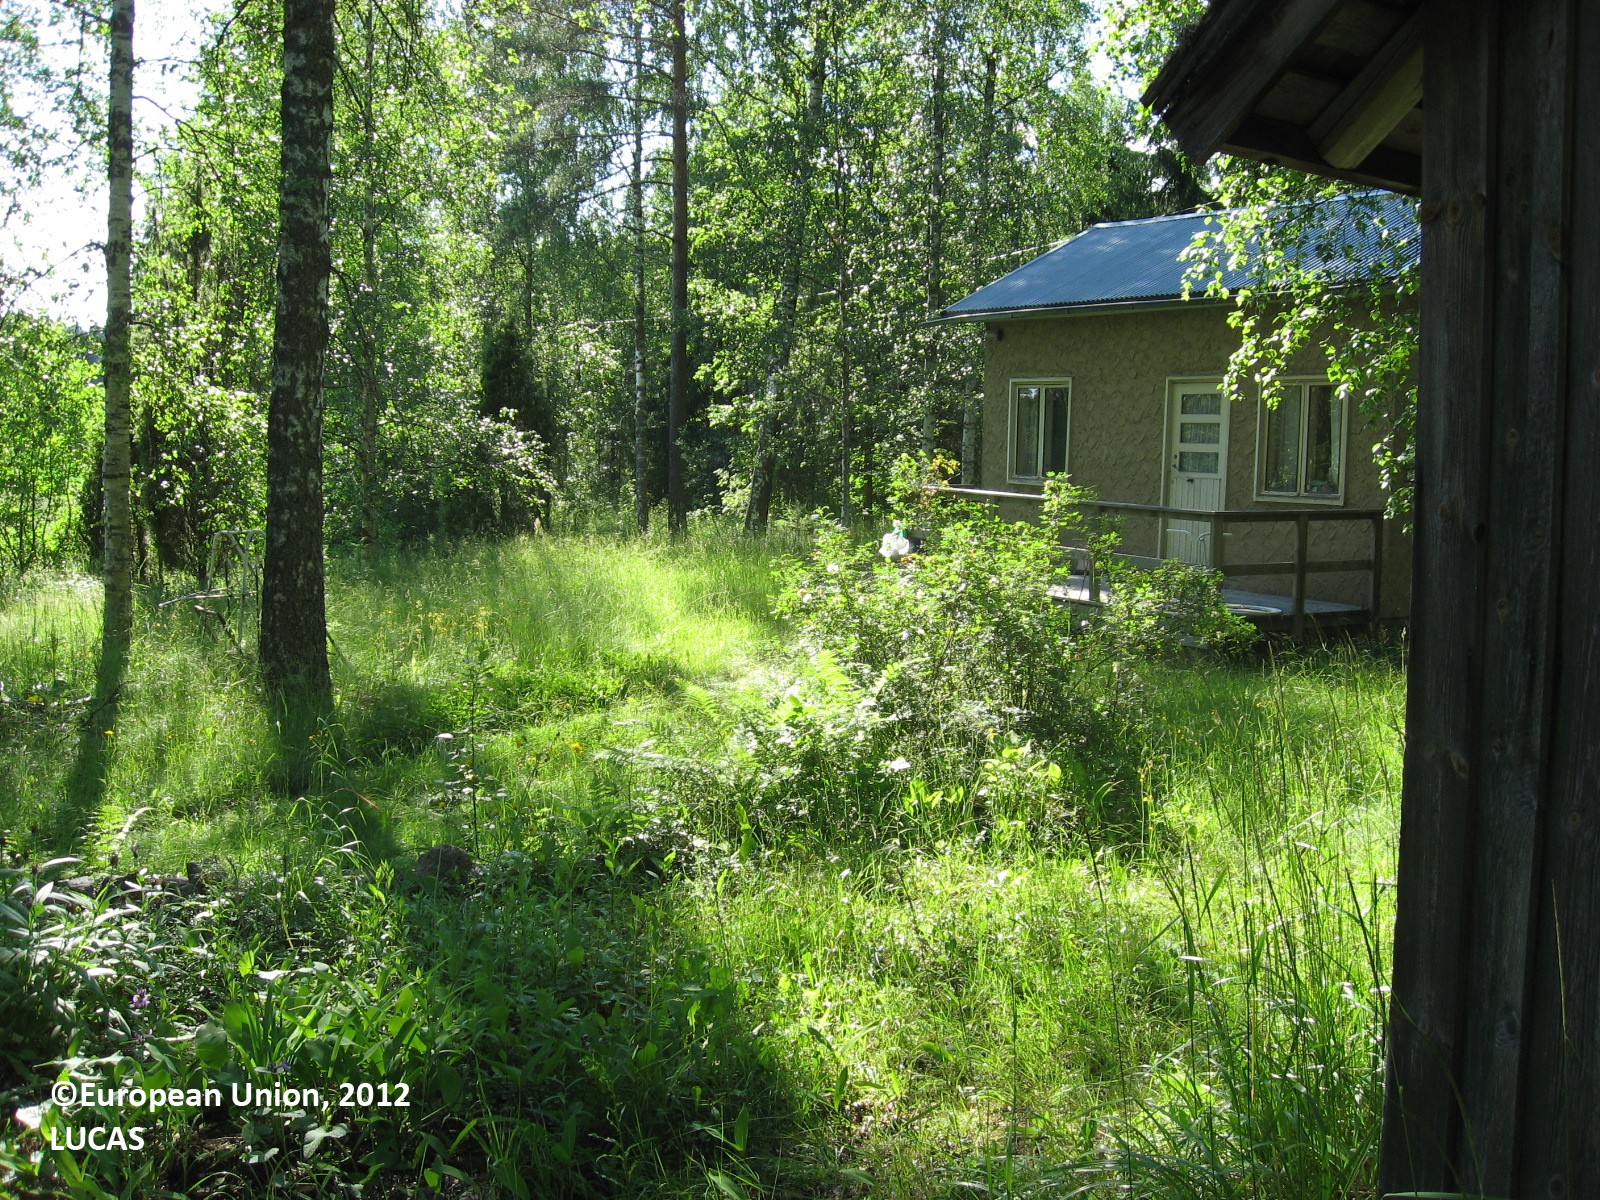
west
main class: Grassland
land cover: Grassland without tree/shrub cover
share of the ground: > 75 %
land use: Residential
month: July
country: FI
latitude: 60.9699
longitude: 26.3490
